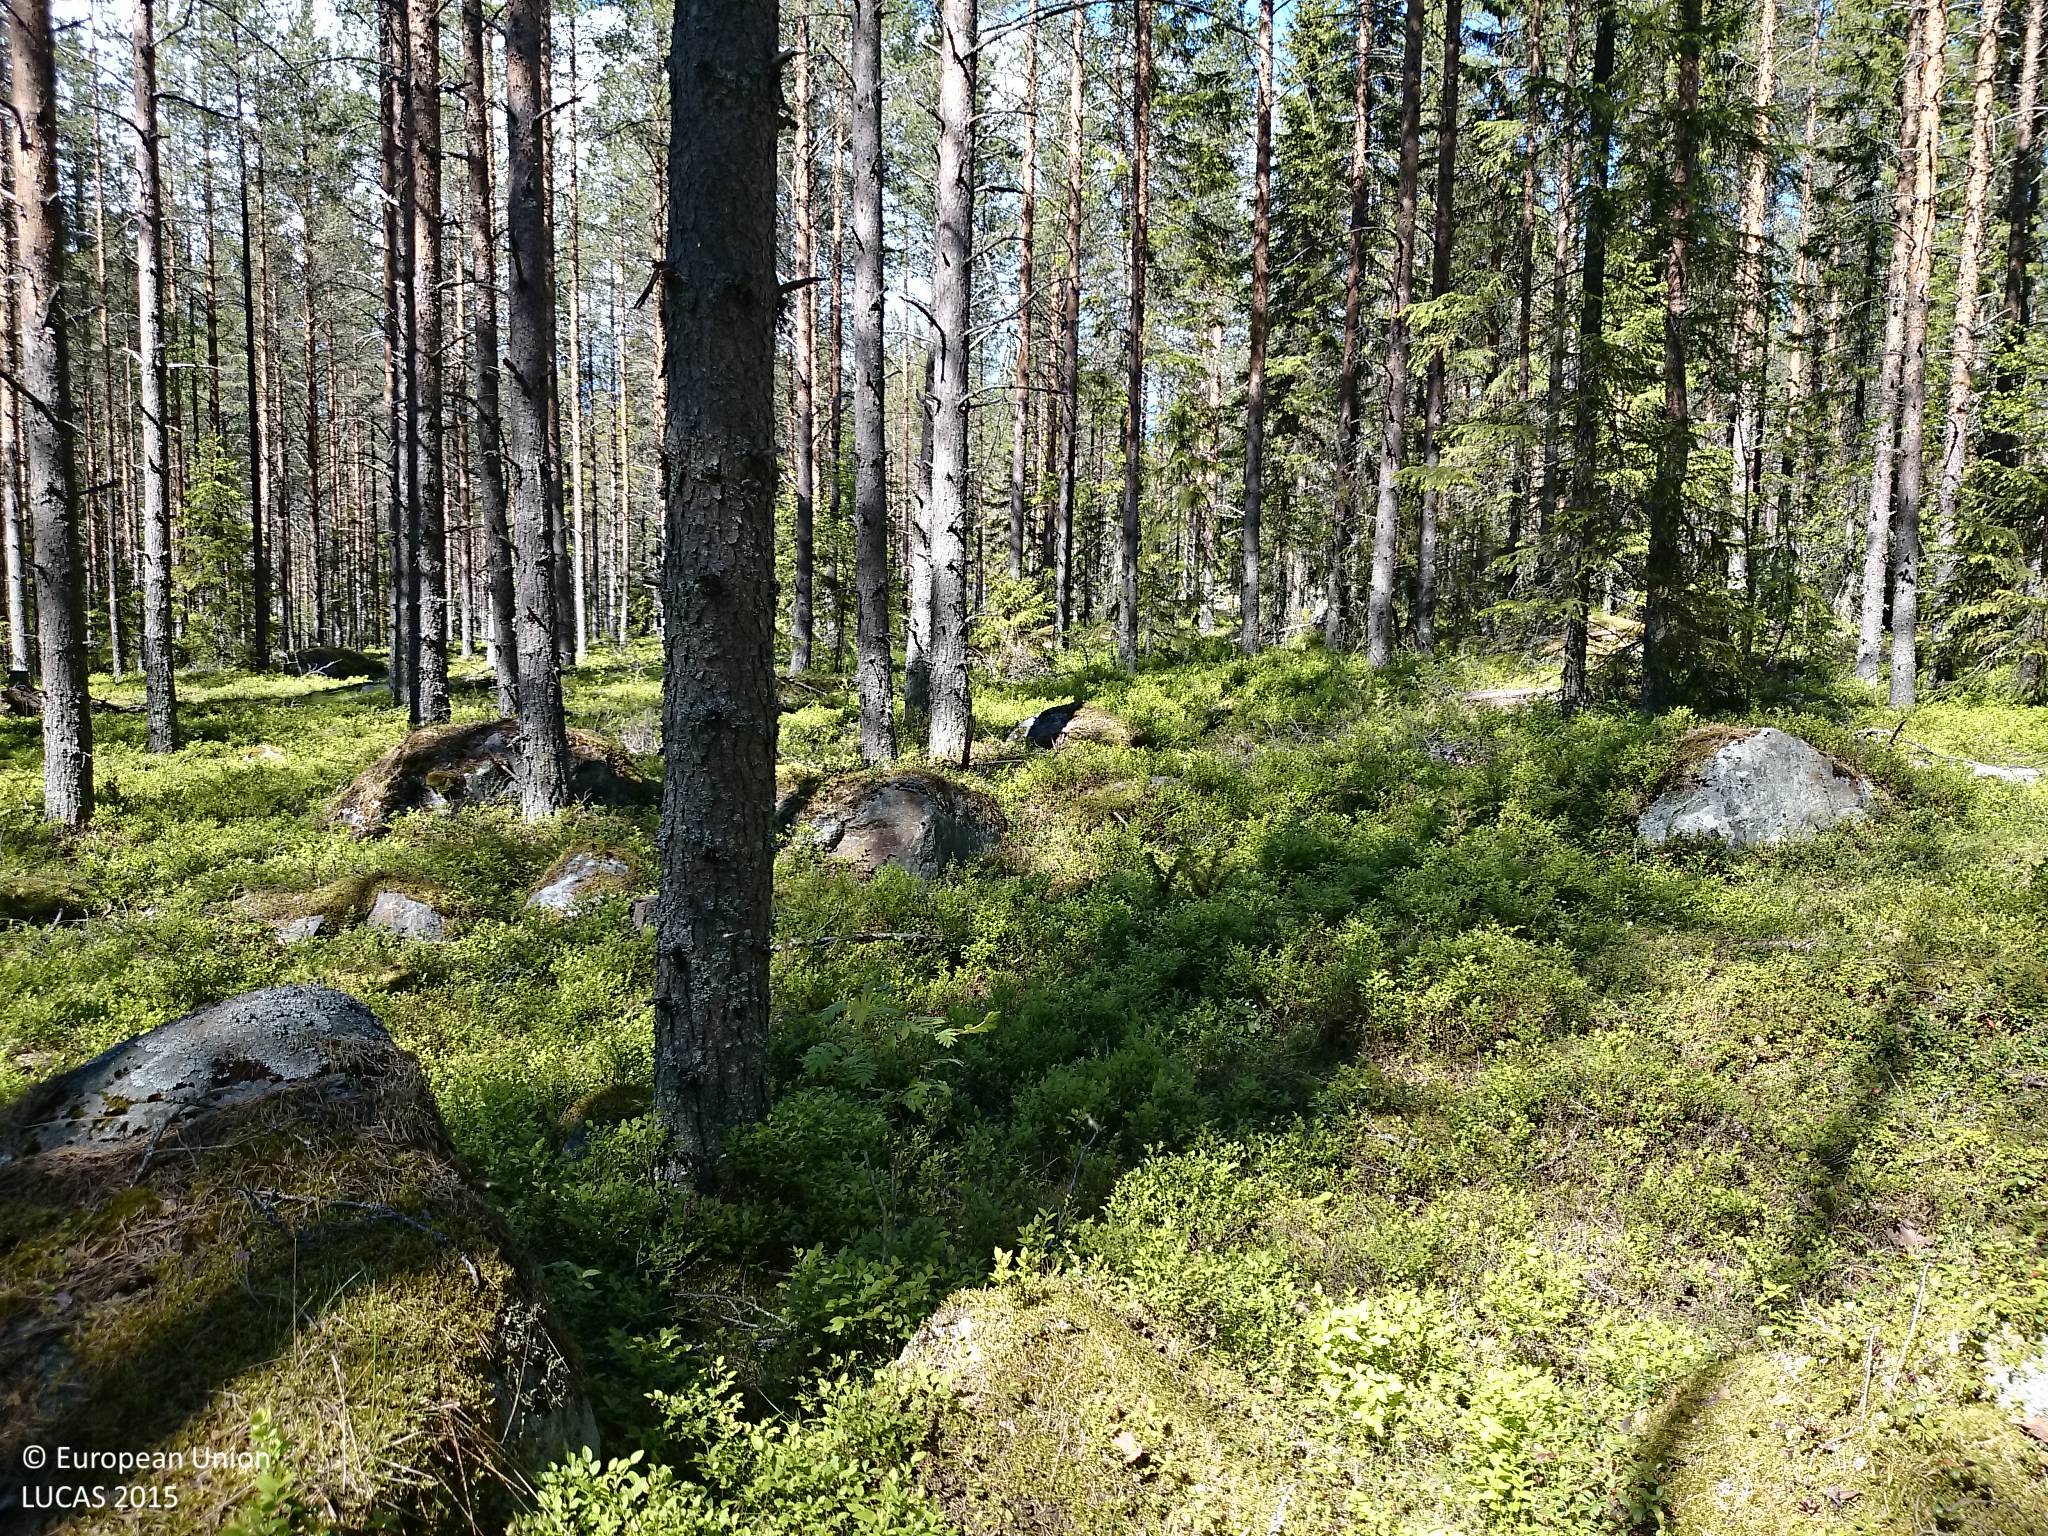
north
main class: Woodland
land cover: Pine dominated coniferous woodland
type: boreal forest
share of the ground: 50 - 75 %
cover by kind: coniferous forest trees 65 %, shrubs 35 %
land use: Forestry
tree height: > 5 m
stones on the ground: > 50 %
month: June
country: SE
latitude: 63.9597
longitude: 20.7436
